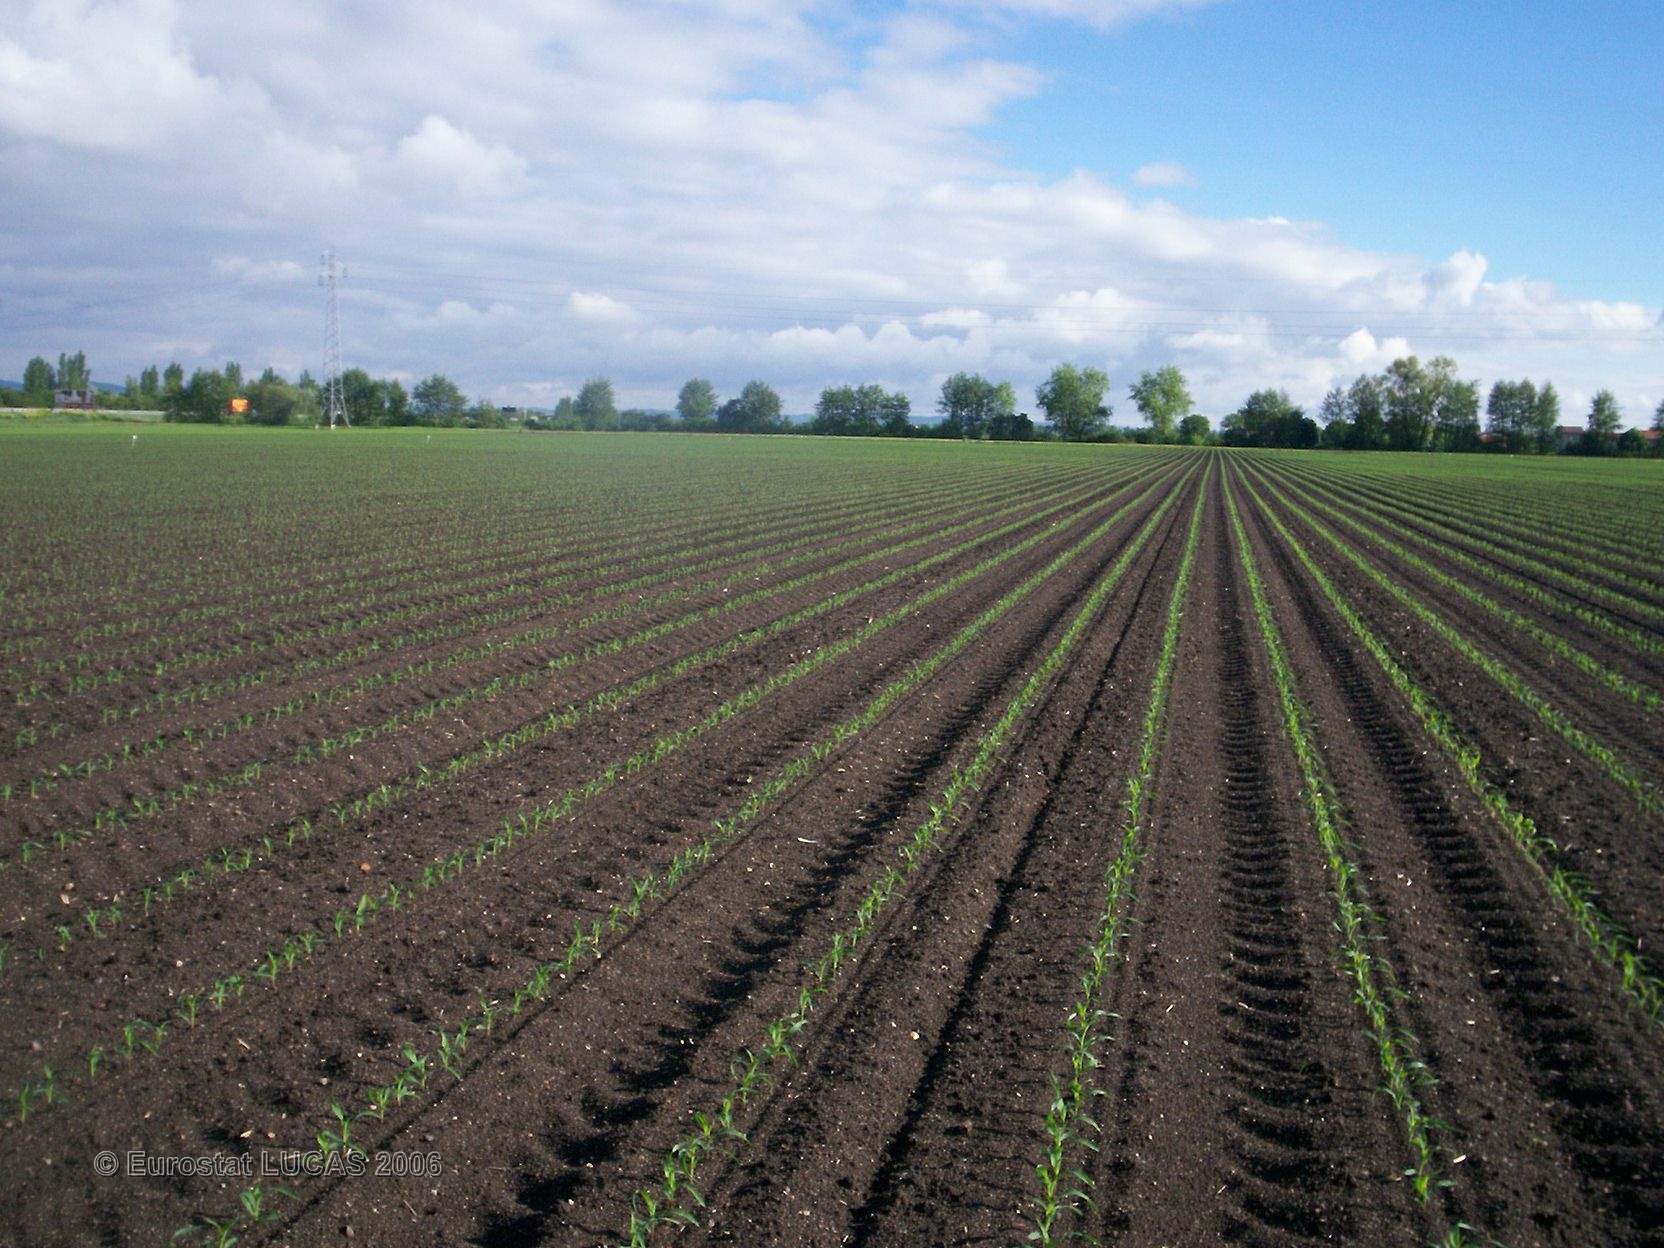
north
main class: Cropland
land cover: Maize
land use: Agriculture (excluding fallow land and kitchen gardens)
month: May
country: FR
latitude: 45.8610
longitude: 3.1603
